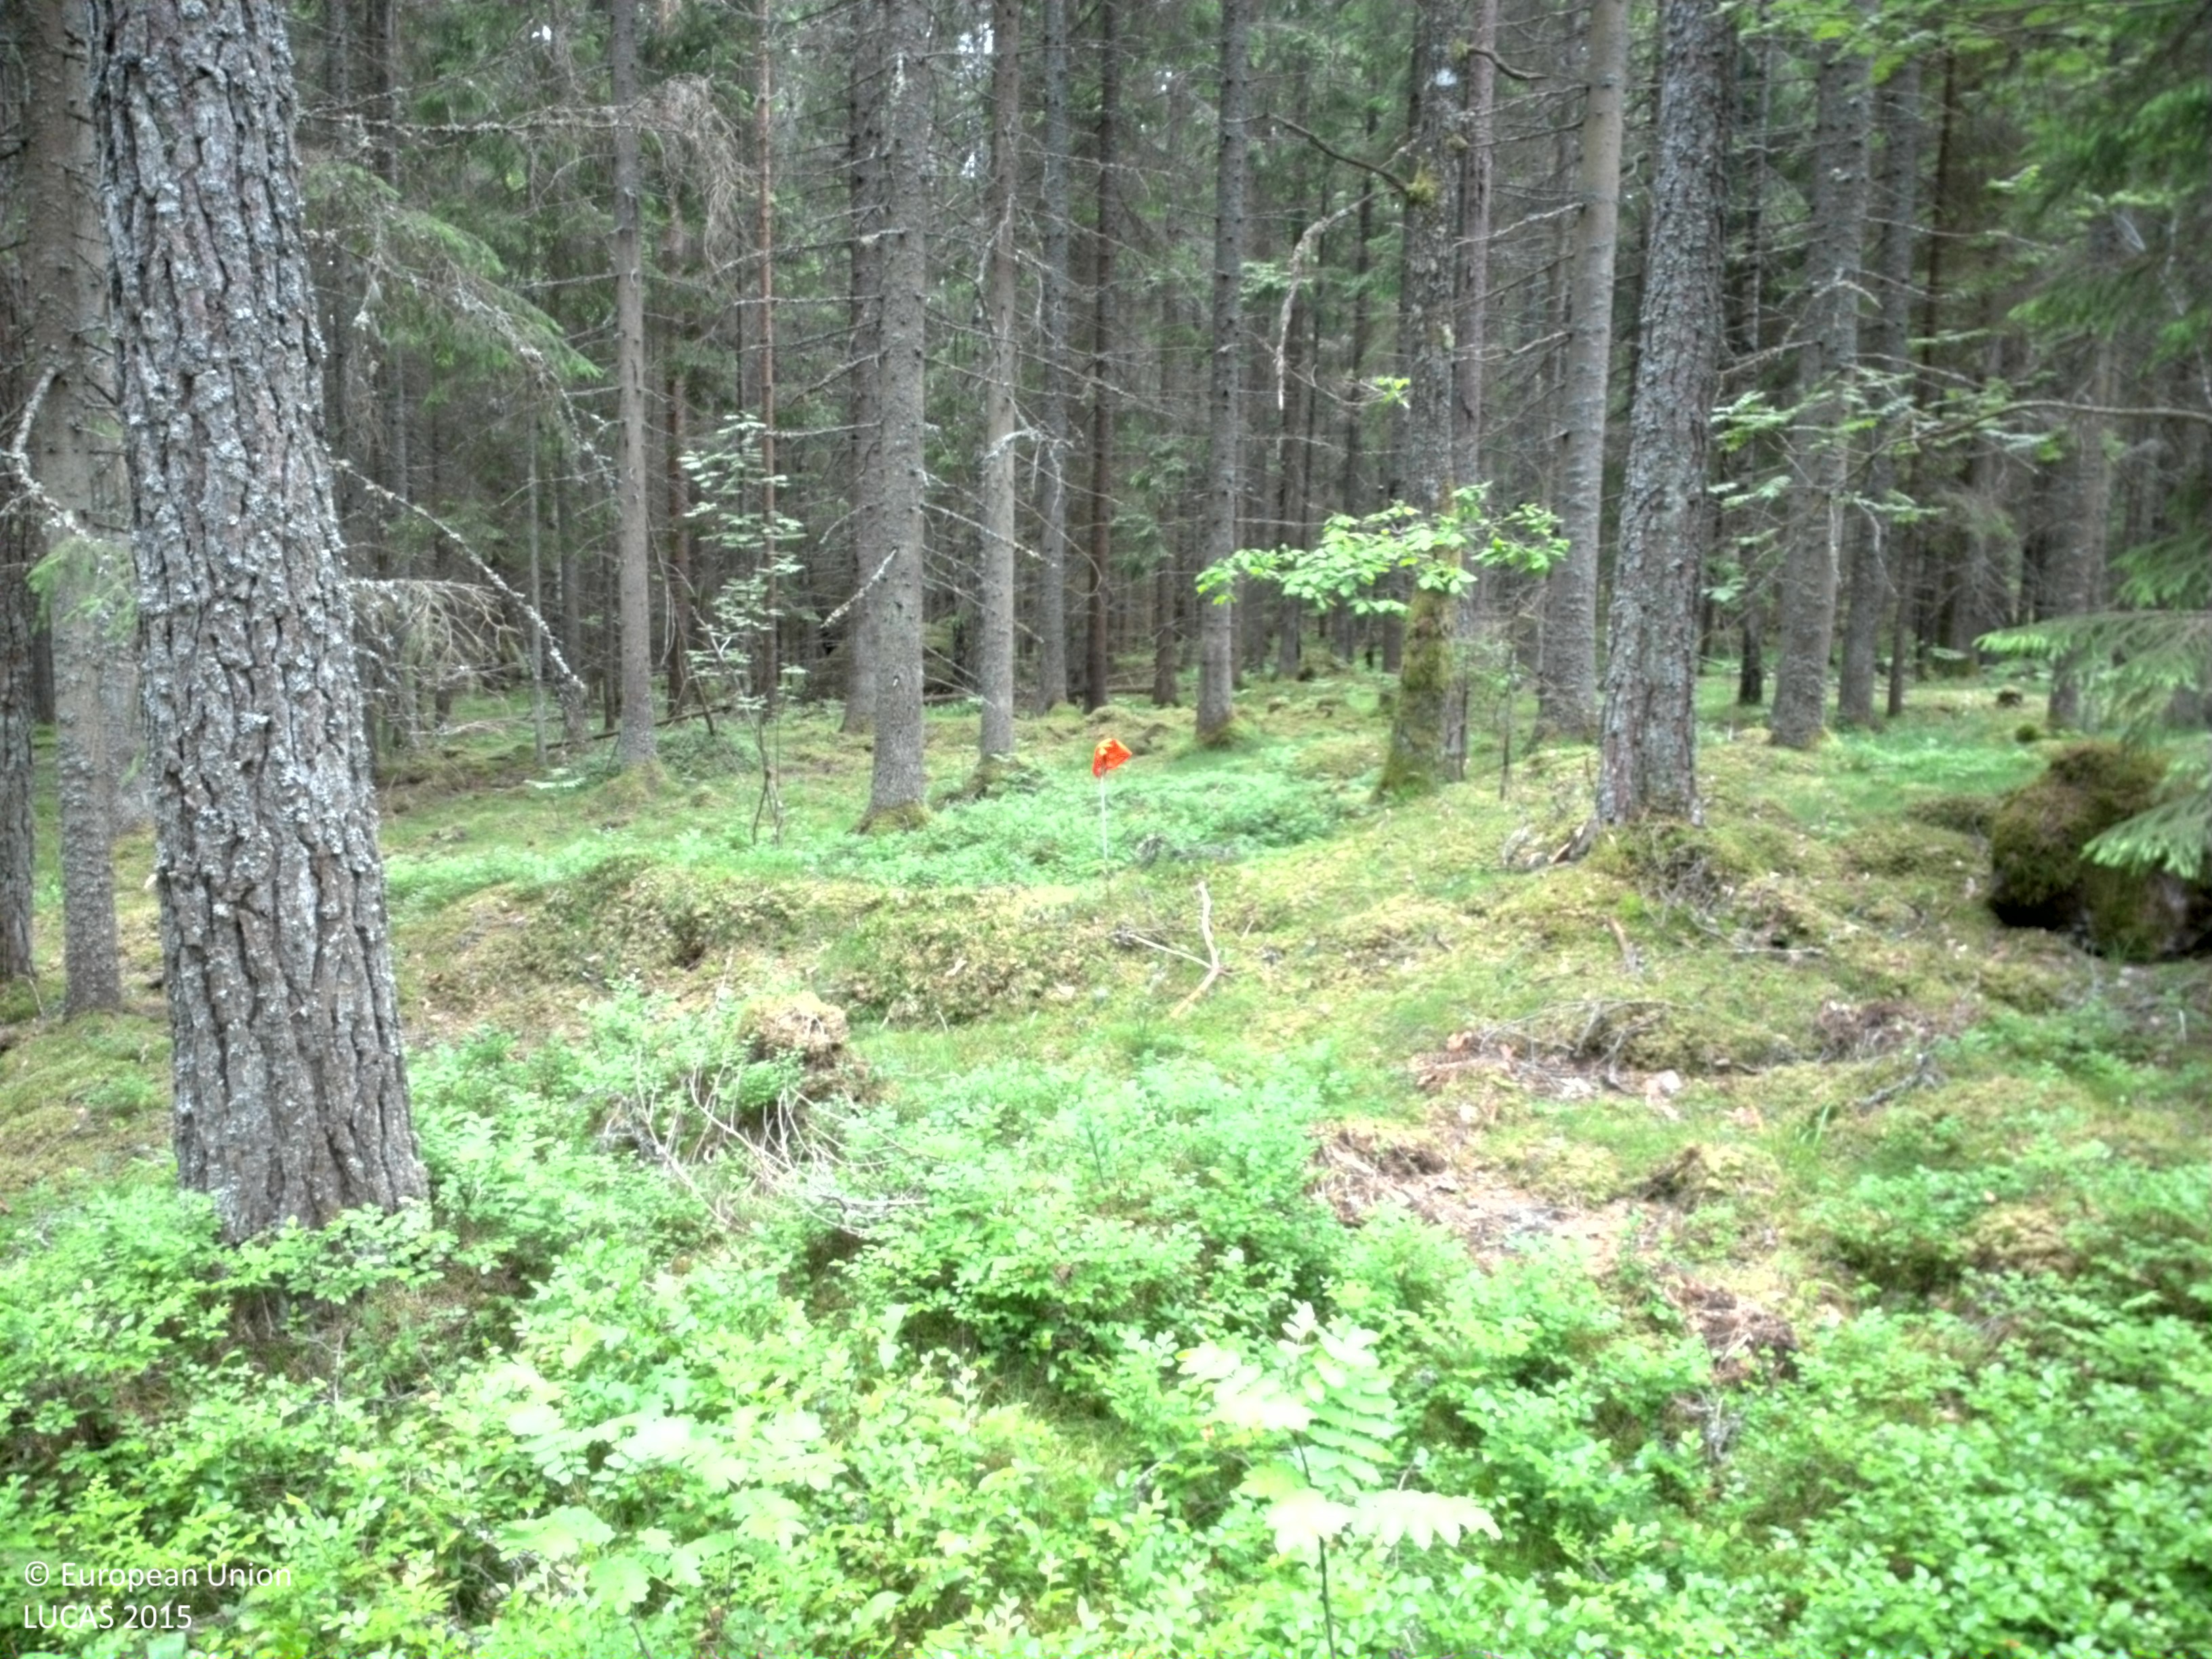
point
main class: Woodland
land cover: Spruce dominated coniferous woodland
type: boreal forest
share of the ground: 25 - 50 %
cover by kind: coniferous forest trees 40 %, herbaceous plants 35 %, lichens and mosses 20 %, broadleaved forest trees 5 %
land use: Forestry
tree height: > 5 m
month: June
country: SE
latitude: 58.7367
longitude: 15.5390
